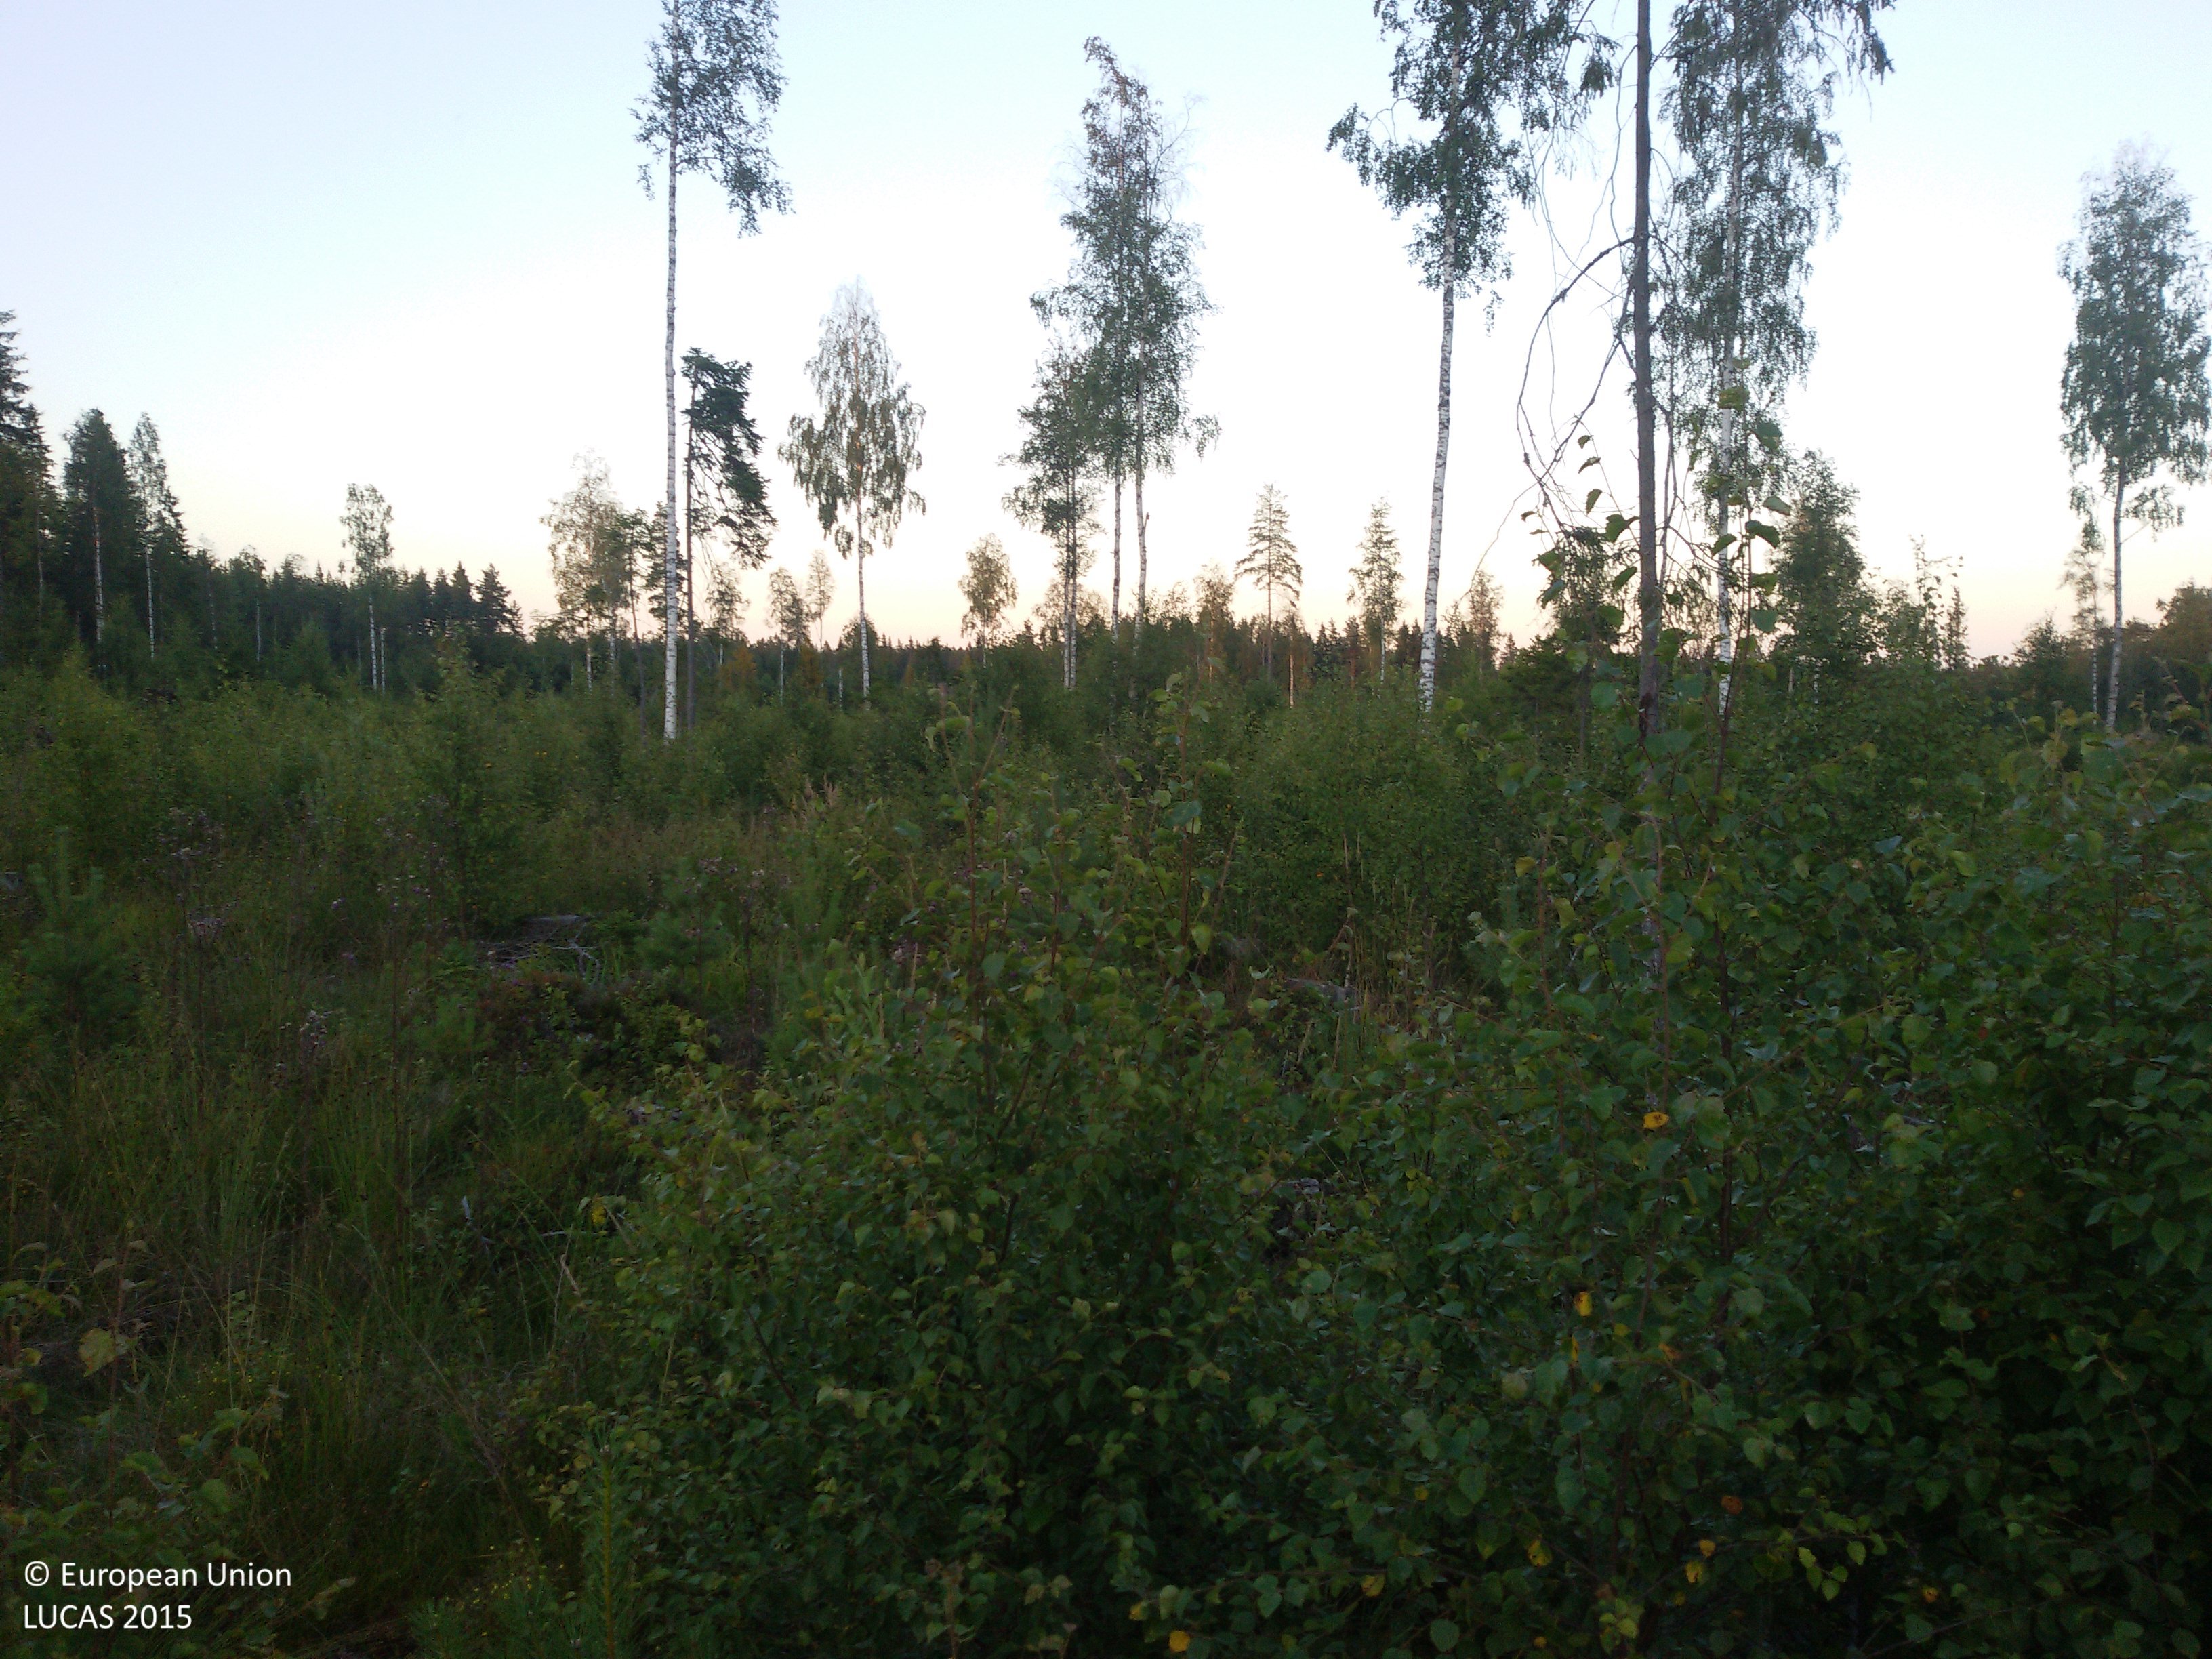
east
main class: Woodland
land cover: Broadleaved woodland
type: boreal forest
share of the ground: 50 - 75 %
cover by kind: broadleaved forest trees 50 %, herbaceous plants 40 %, coniferous forest trees 10 %
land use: Forestry
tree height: < 5 m
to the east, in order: Broadleaved woodland; Ditches and canals; Broadleaved woodland
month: August
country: SE
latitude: 60.6412
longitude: 16.5890
